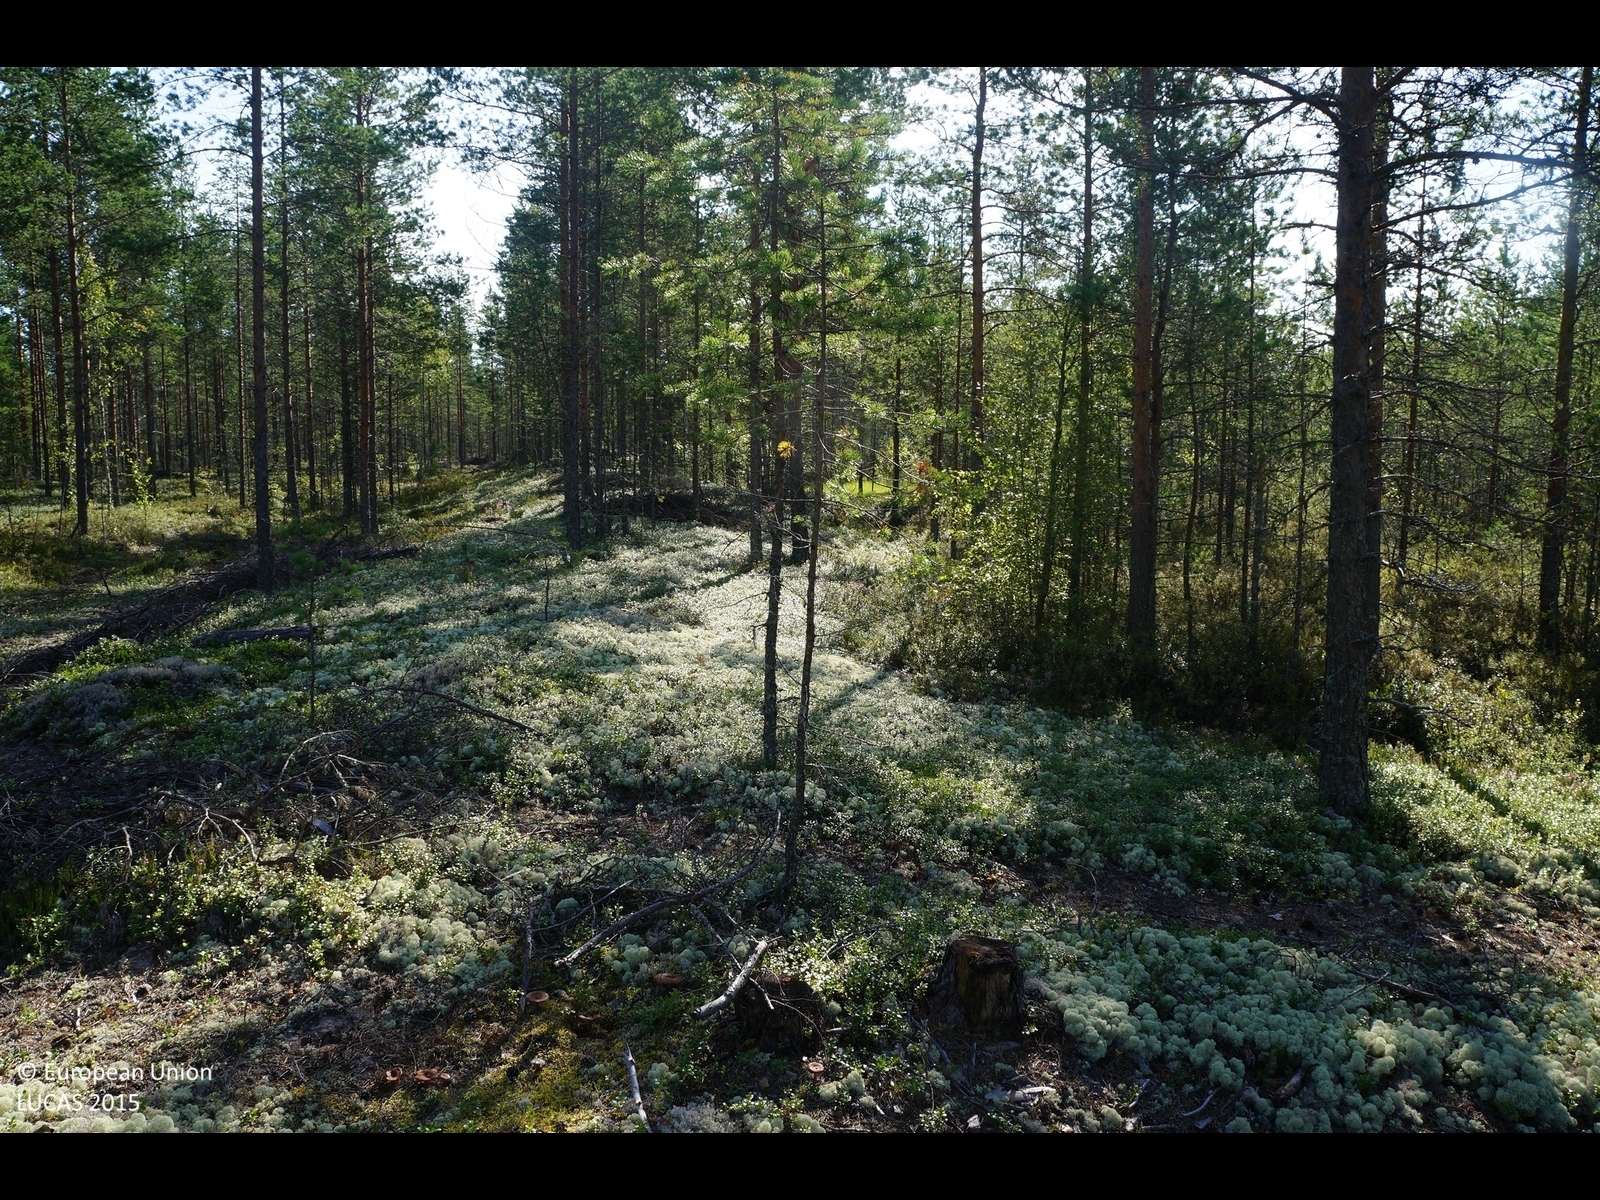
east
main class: Woodland
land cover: Pine dominated coniferous woodland
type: boreal forest
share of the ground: 25 - 50 %
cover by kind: coniferous forest trees 40 %, shrubs 30 %, lichens and mosses 30 %
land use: Forestry
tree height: > 5 m
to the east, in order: Pine dominated coniferous woodland; Pine dominated mixed woodland; Pine dominated coniferous woodland
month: August
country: FI
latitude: 64.8483
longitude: 24.9402
